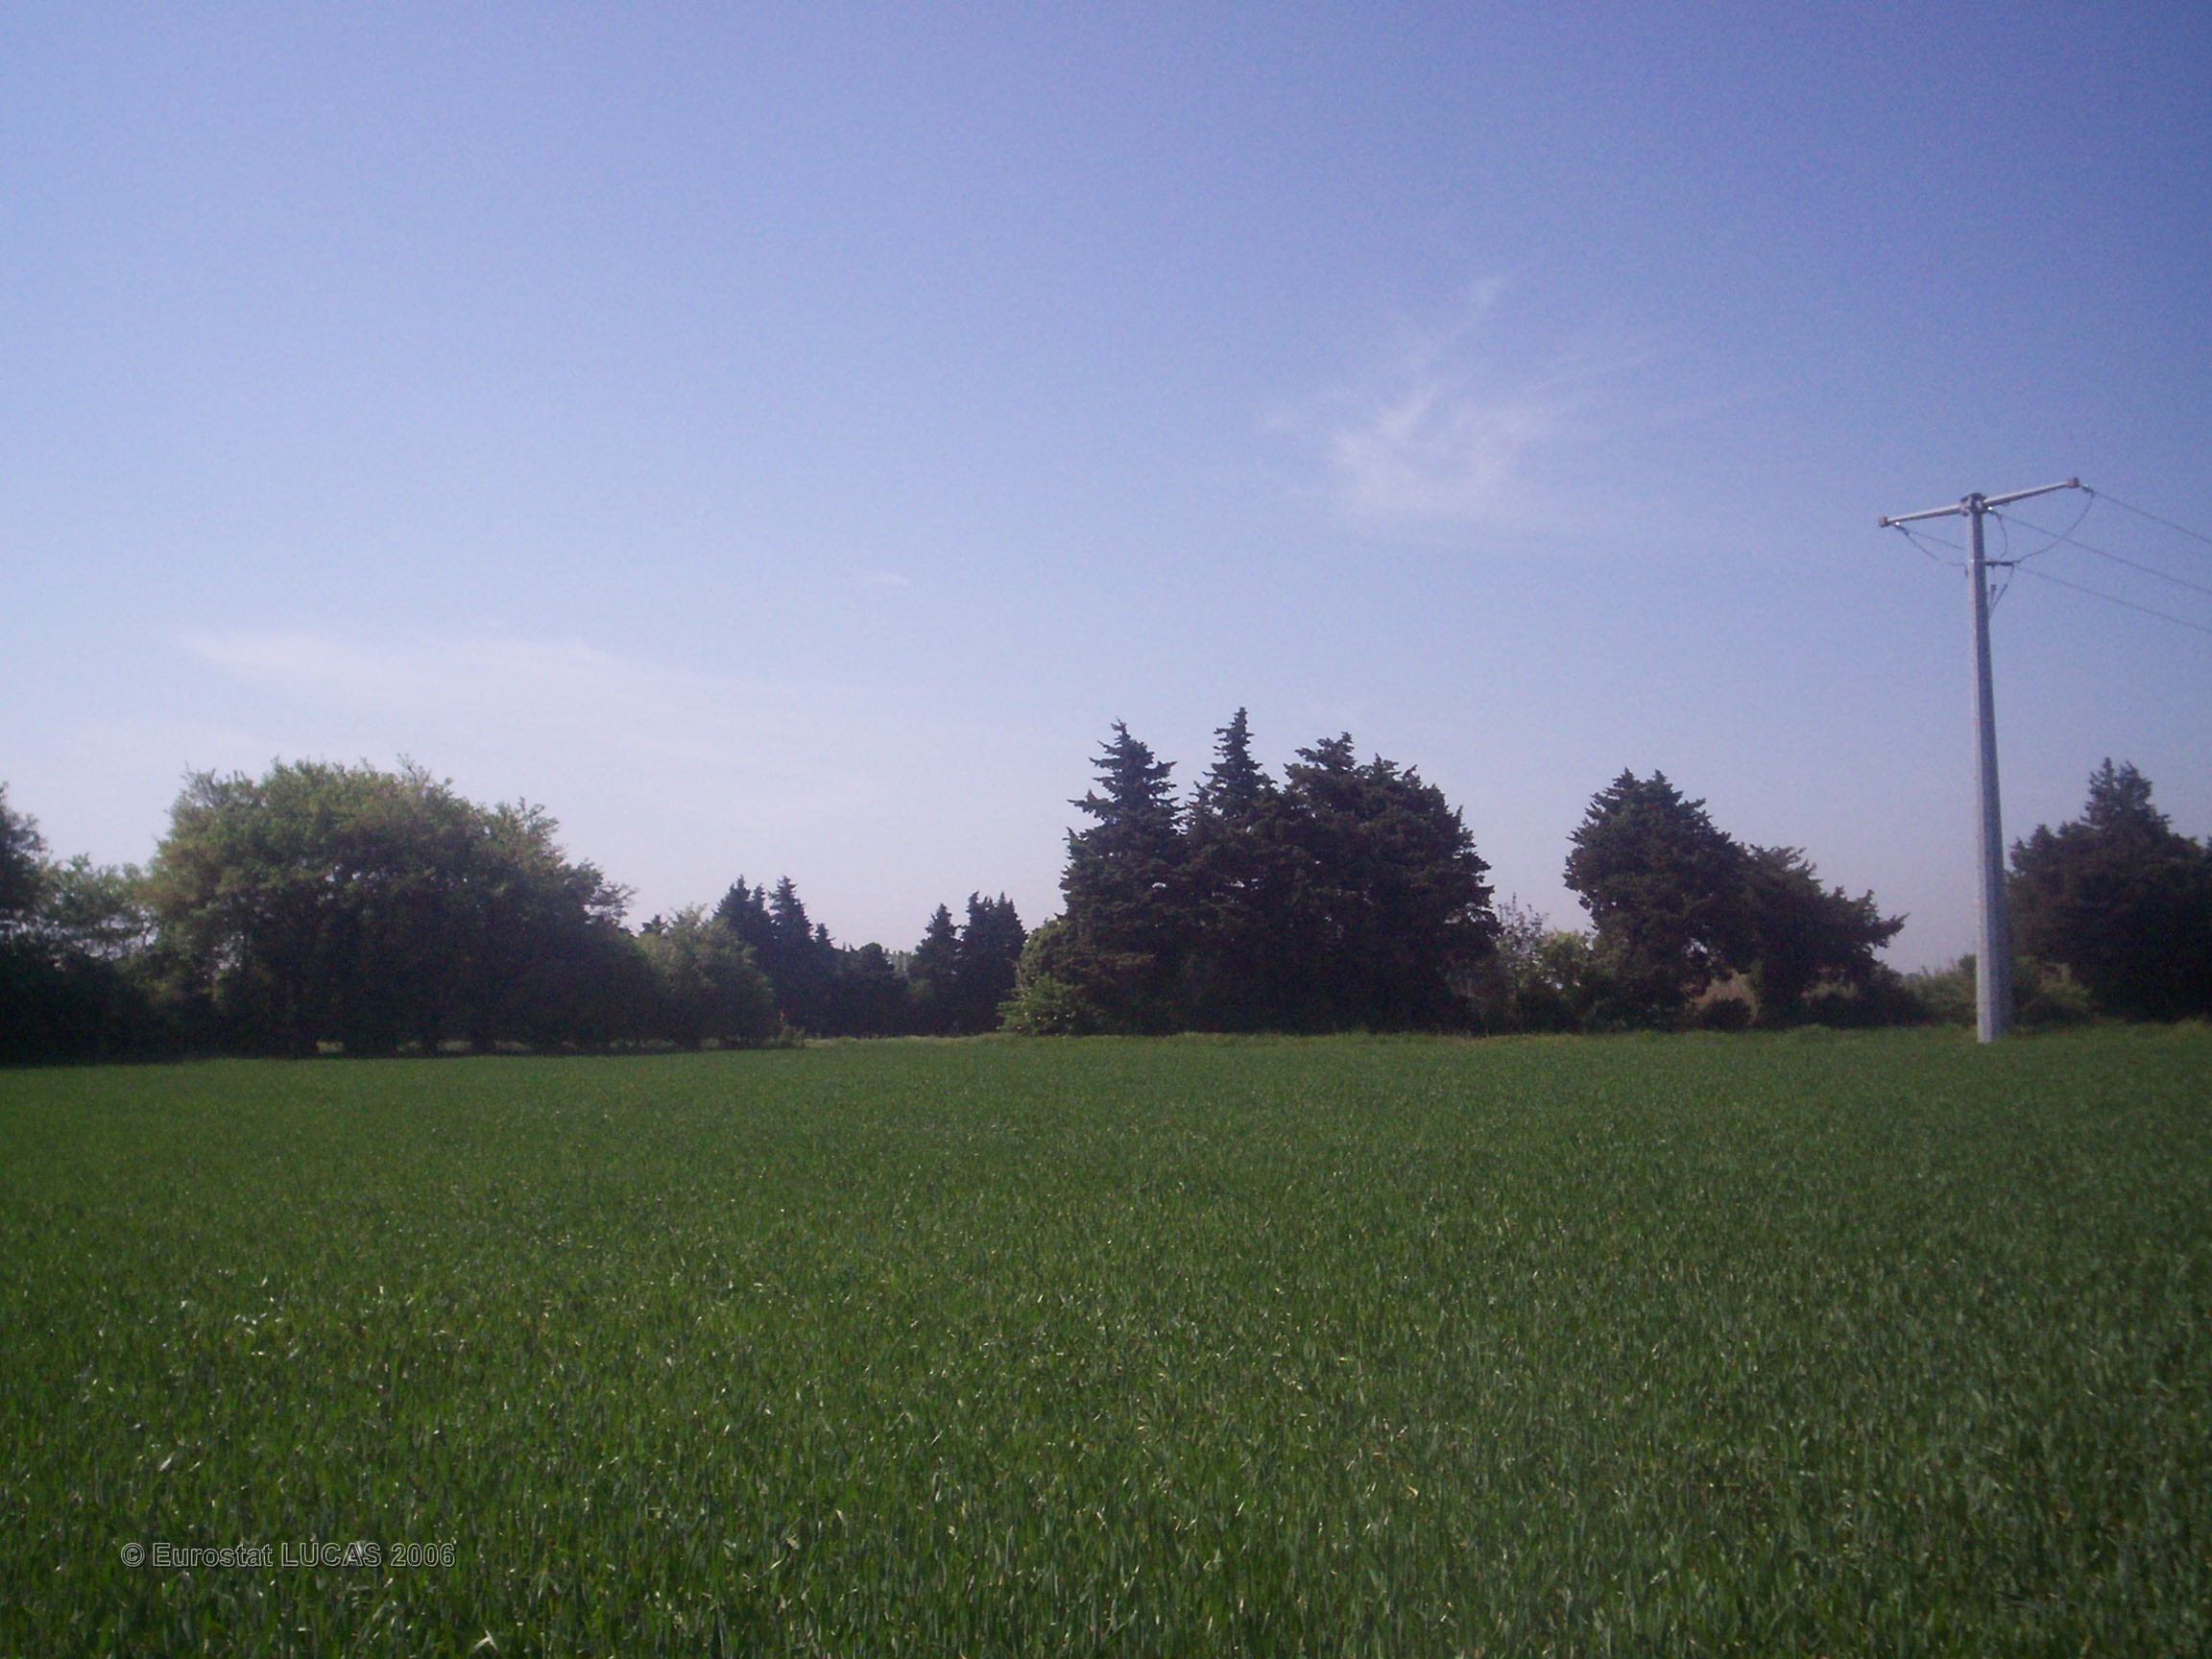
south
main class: Cropland
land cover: Durum wheat
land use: Agriculture (excluding fallow land and kitchen gardens)
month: April
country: FR
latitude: 43.9763
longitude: 4.9847
